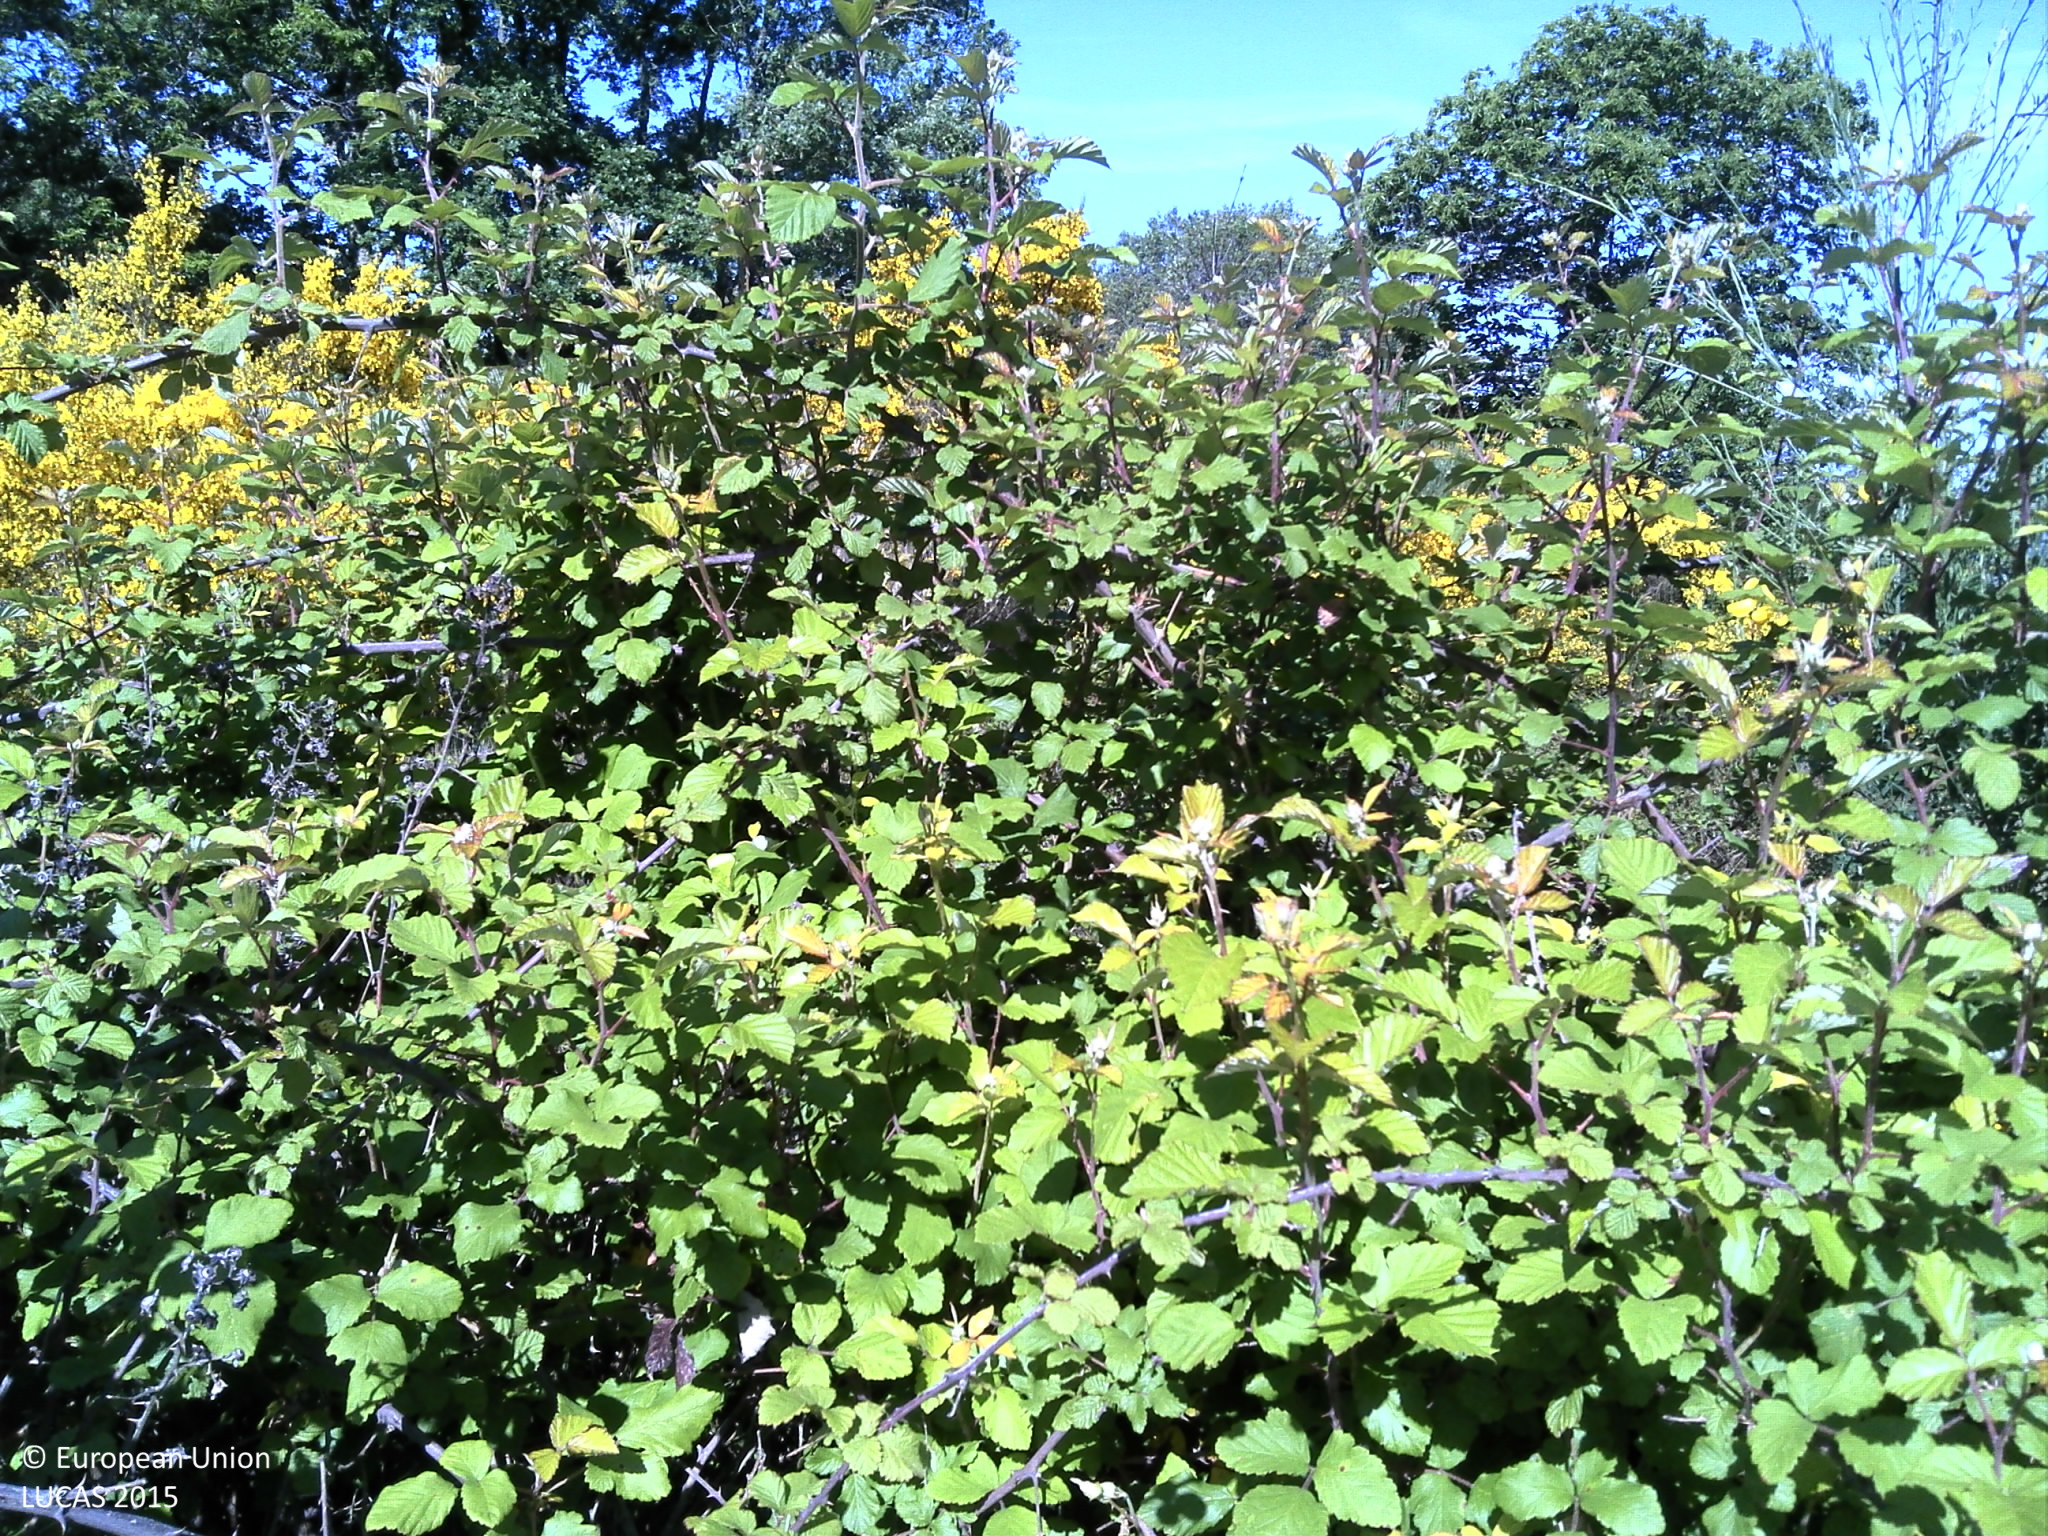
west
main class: Shrubland
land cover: Shrubland without tree cover
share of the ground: 25 - 50 %
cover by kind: herbaceous plants 70 %, shrubs 30 %
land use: Forestry
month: May
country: PT
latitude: 41.7671
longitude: -7.3654
